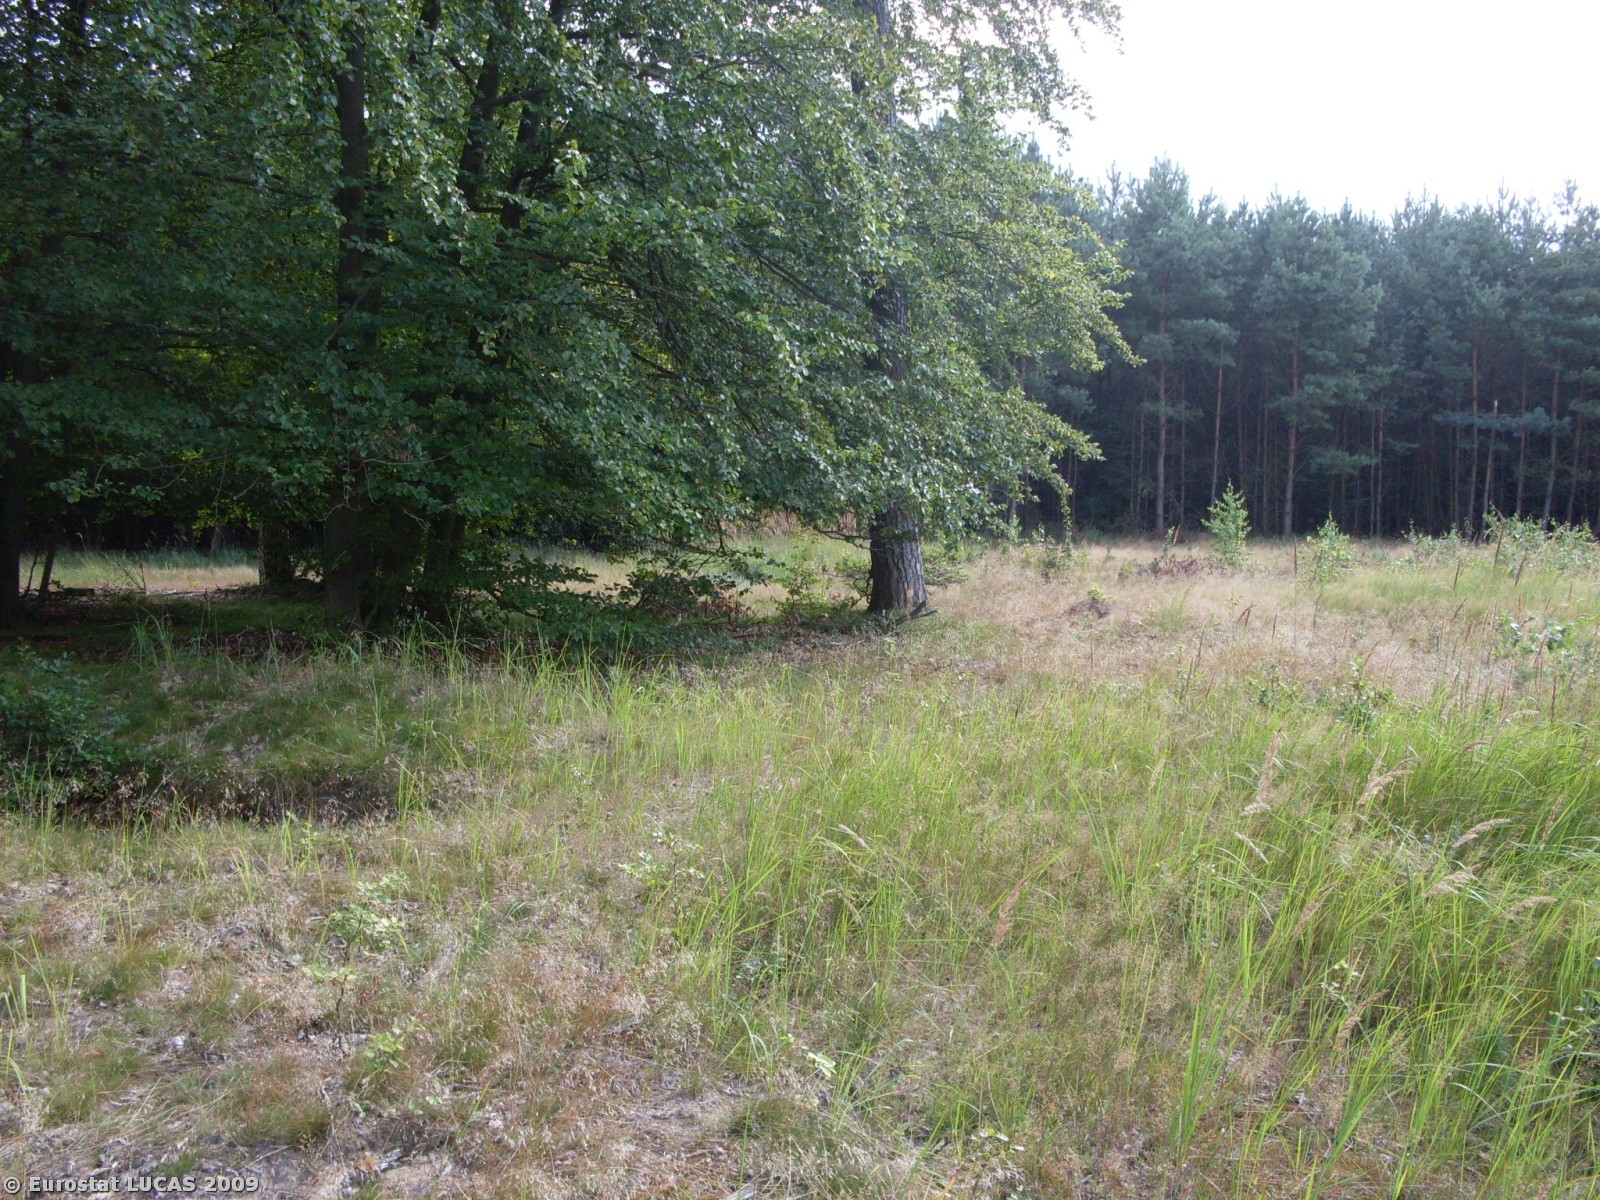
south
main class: Woodland
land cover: Mixed woodland
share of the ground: 10 - 25 %
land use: Forestry
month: August
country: PL
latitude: 52.9019
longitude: 15.4299
